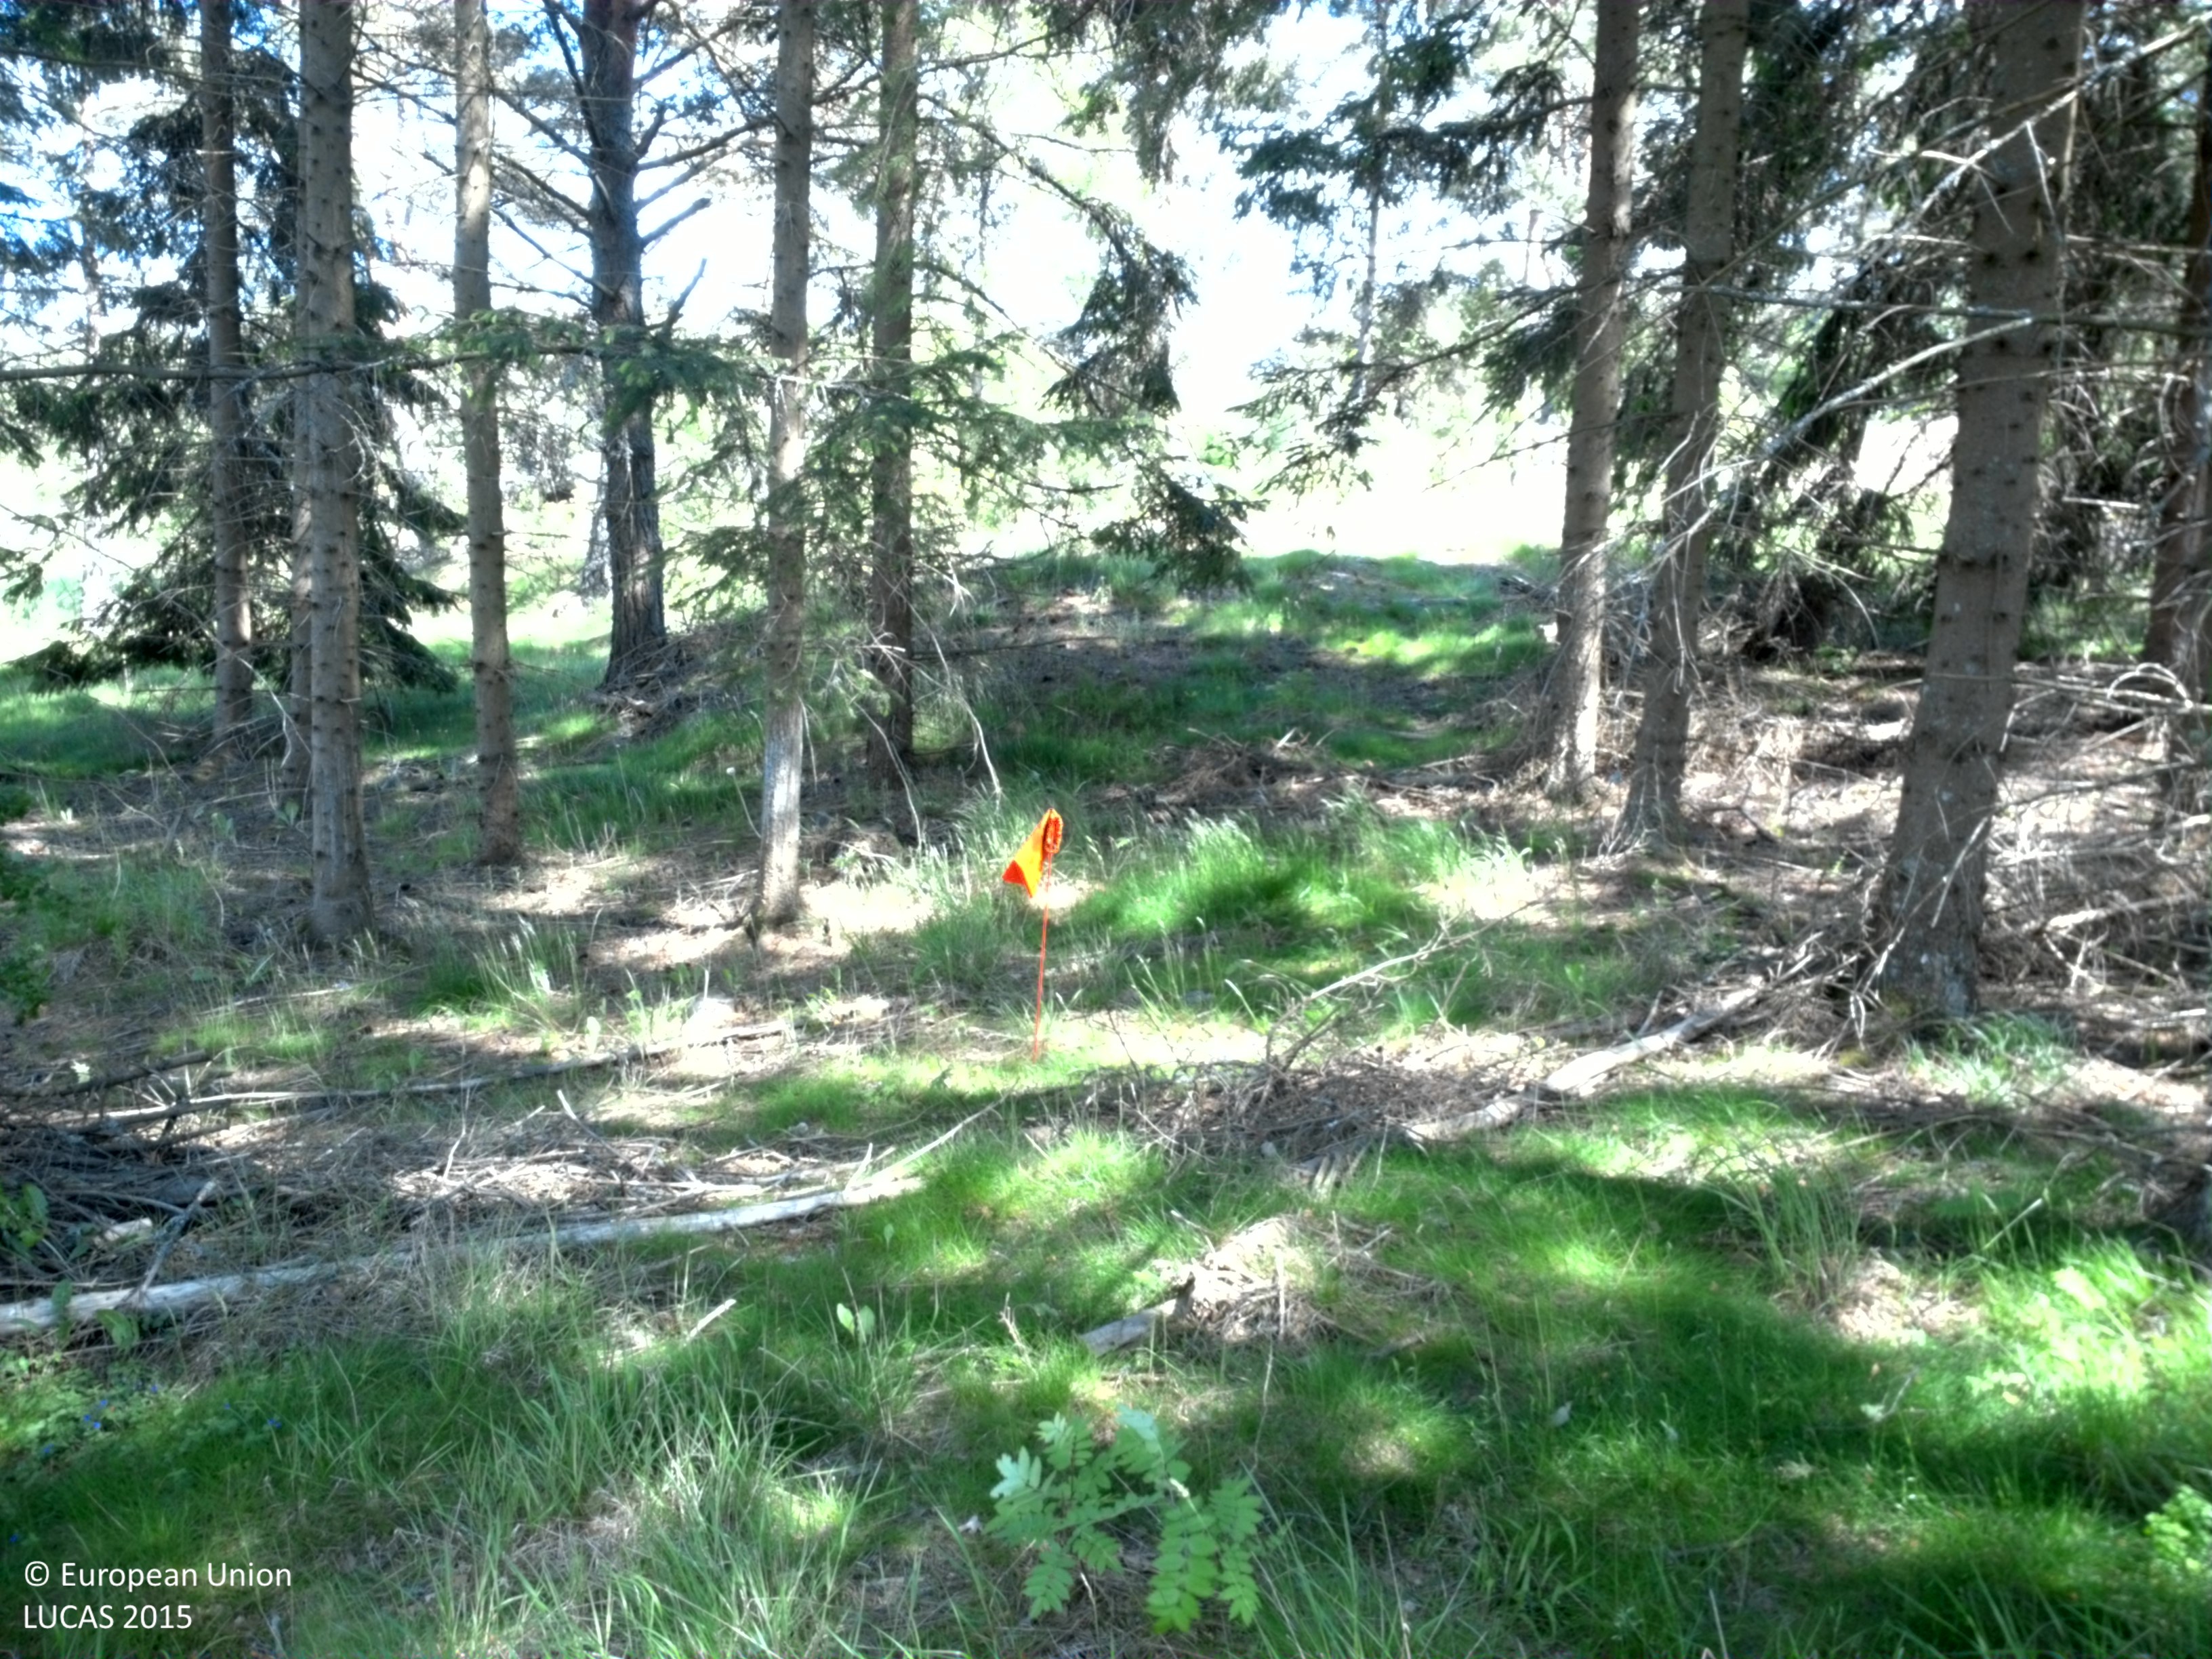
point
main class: Woodland
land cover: Spruce dominated coniferous woodland
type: boreal forest
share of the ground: 50 - 75 %
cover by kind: coniferous forest trees 50 %, lichens and mosses 30 %, herbaceous plants 15 %, broadleaved forest trees 5 %
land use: Forestry
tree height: > 5 m
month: June
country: SE
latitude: 58.4726
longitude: 16.2194
